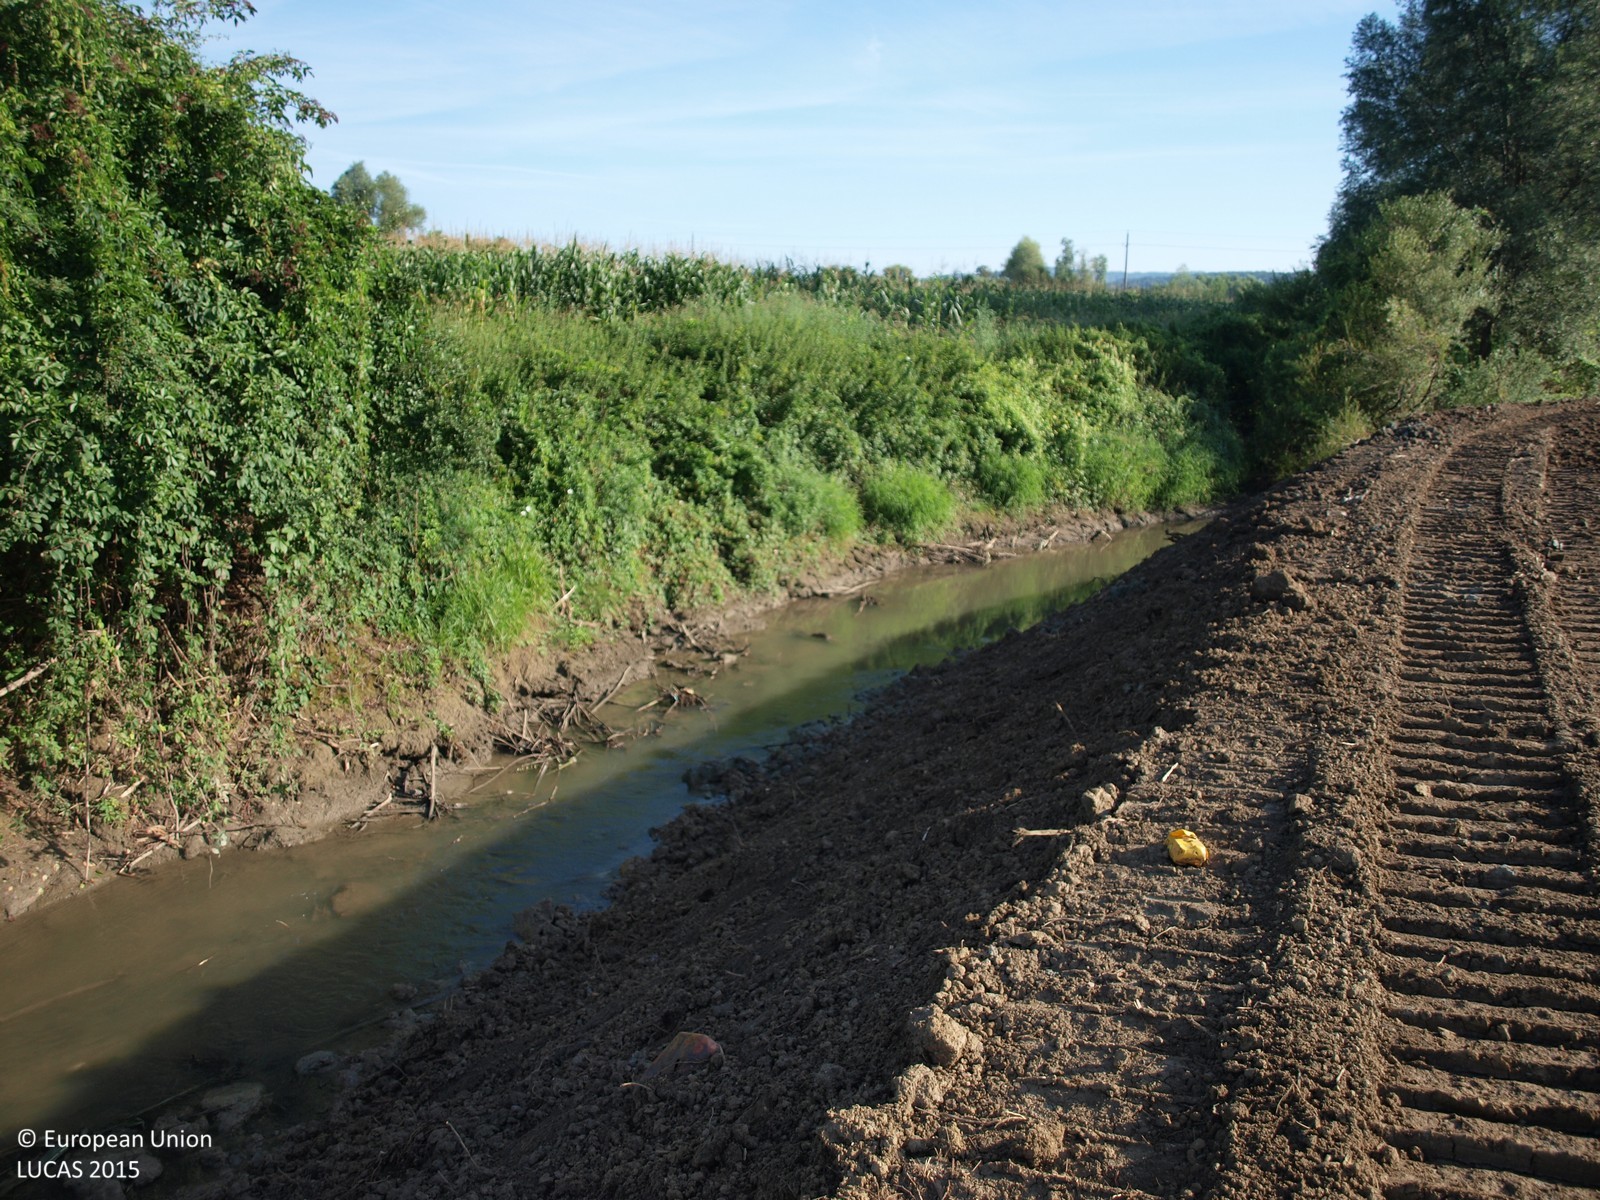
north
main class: Shrubland
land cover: Shrubland with sparse tree cover
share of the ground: > 75 %
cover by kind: shrubs 95 %, broadleaved forest trees 5 %
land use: Semi-natural and natural areas not in use
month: August
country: HR
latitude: 46.0395
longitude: 16.2921
